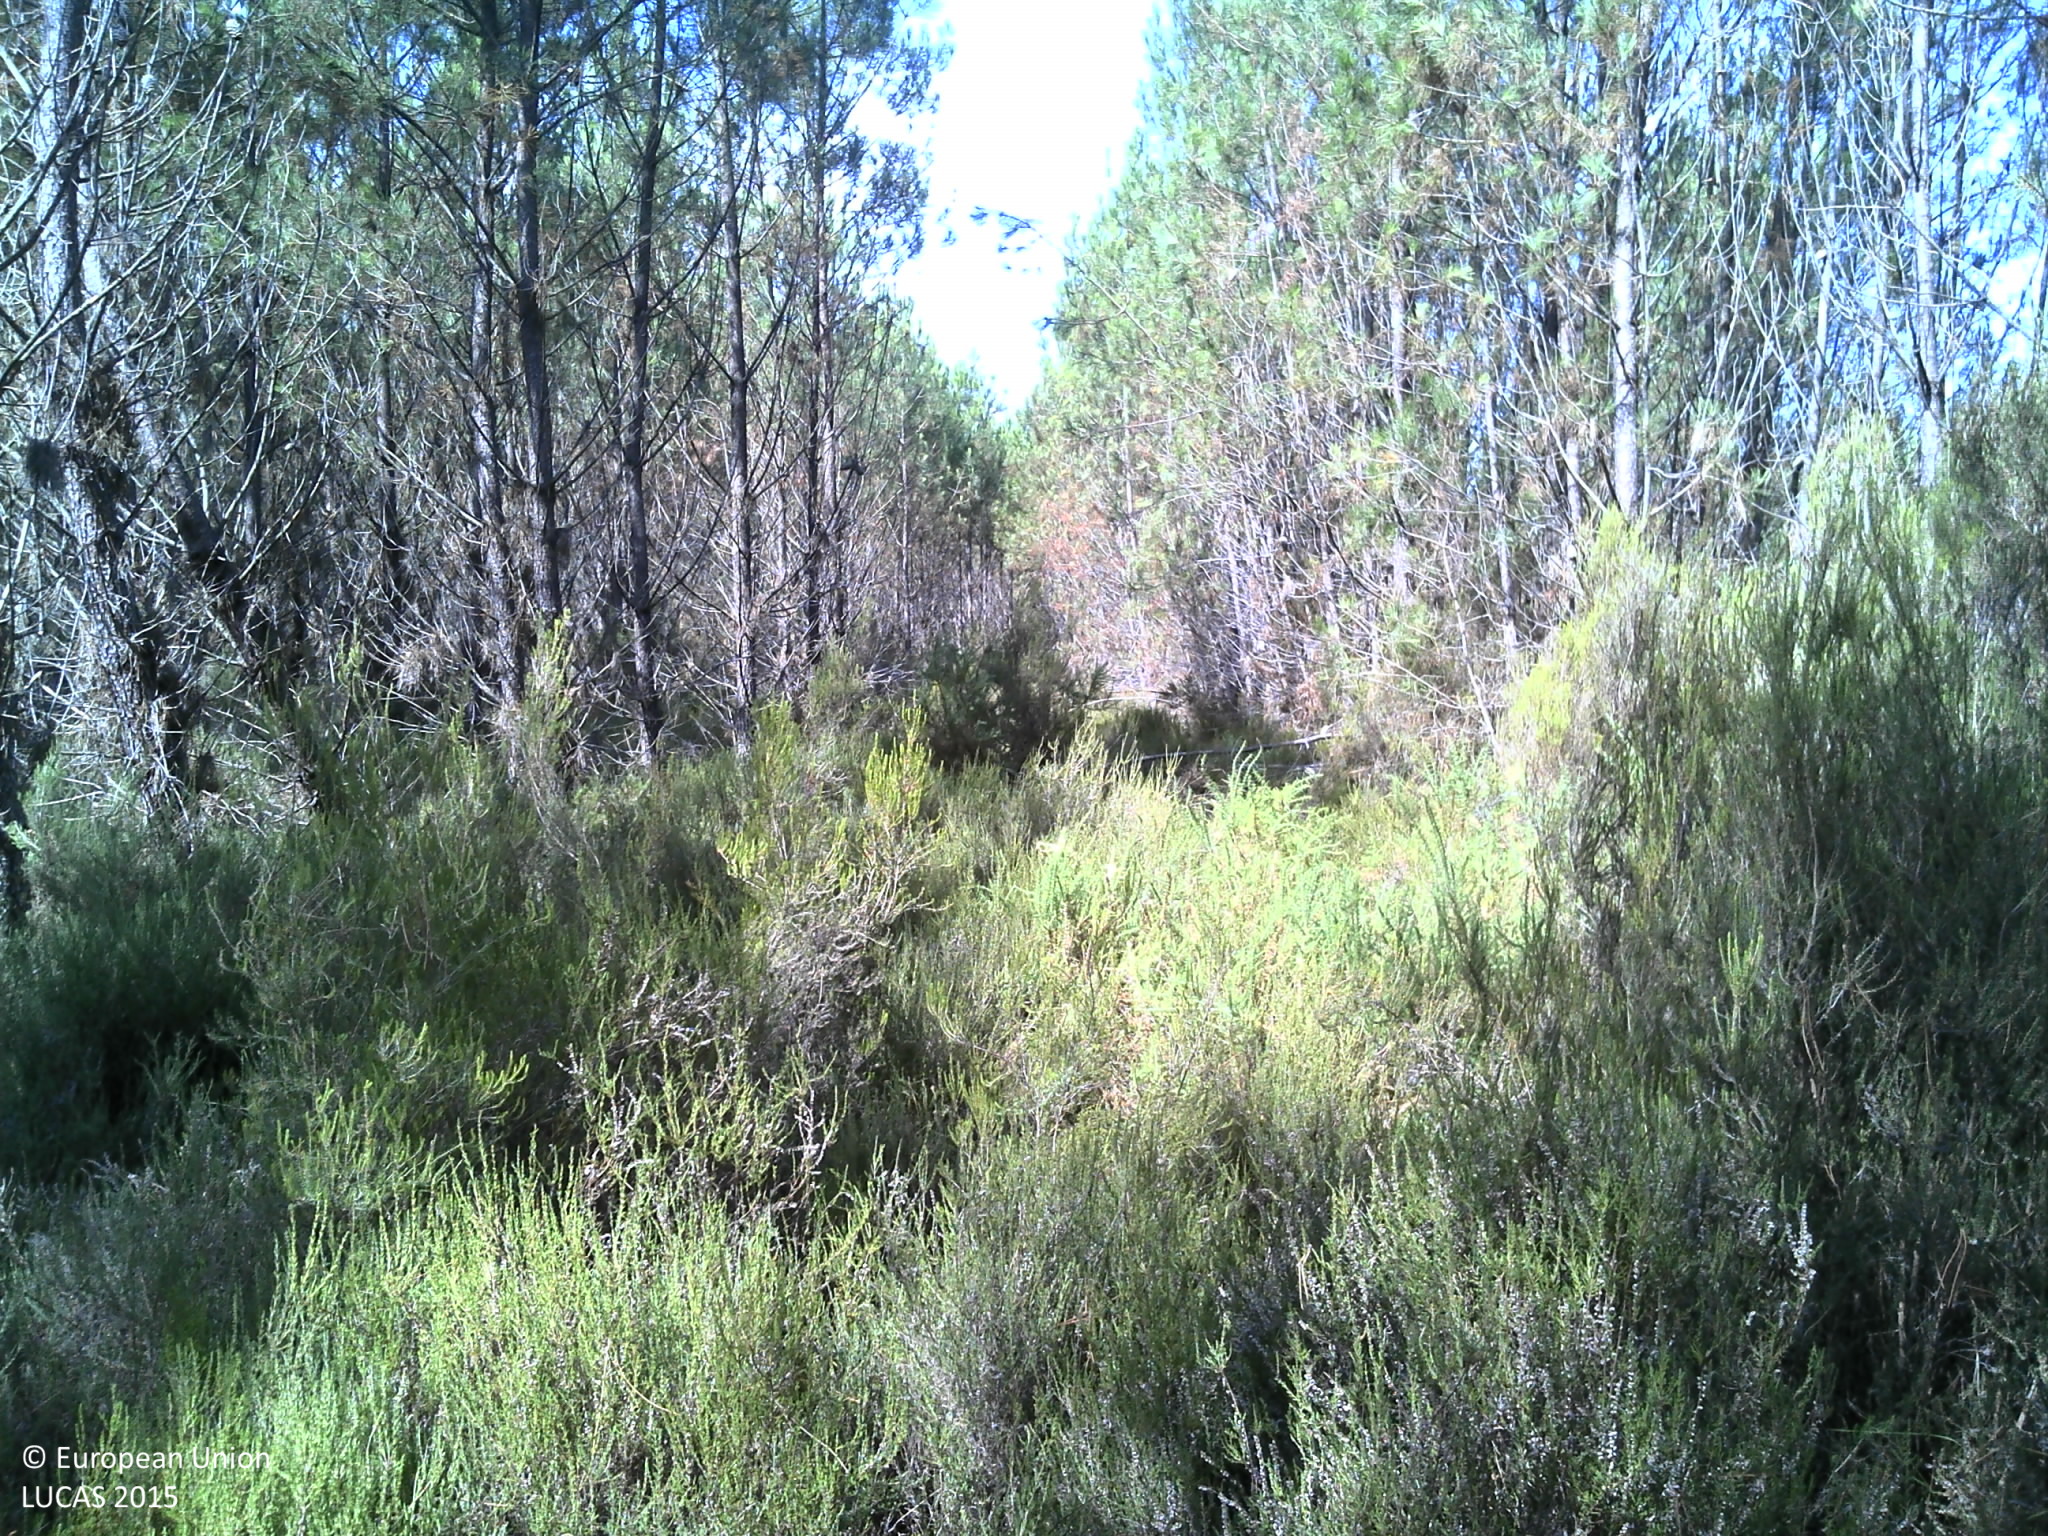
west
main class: Woodland
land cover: Pine dominated coniferous woodland
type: coniferous forest of the mediterranean region
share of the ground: > 75 %
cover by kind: coniferous forest trees 60 %, shrubs 30 %, herbaceous plants 5 %, lichens and mosses 5 %
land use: Forestry
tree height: > 5 m
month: July
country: FR
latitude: 44.4134
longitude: -0.5269
